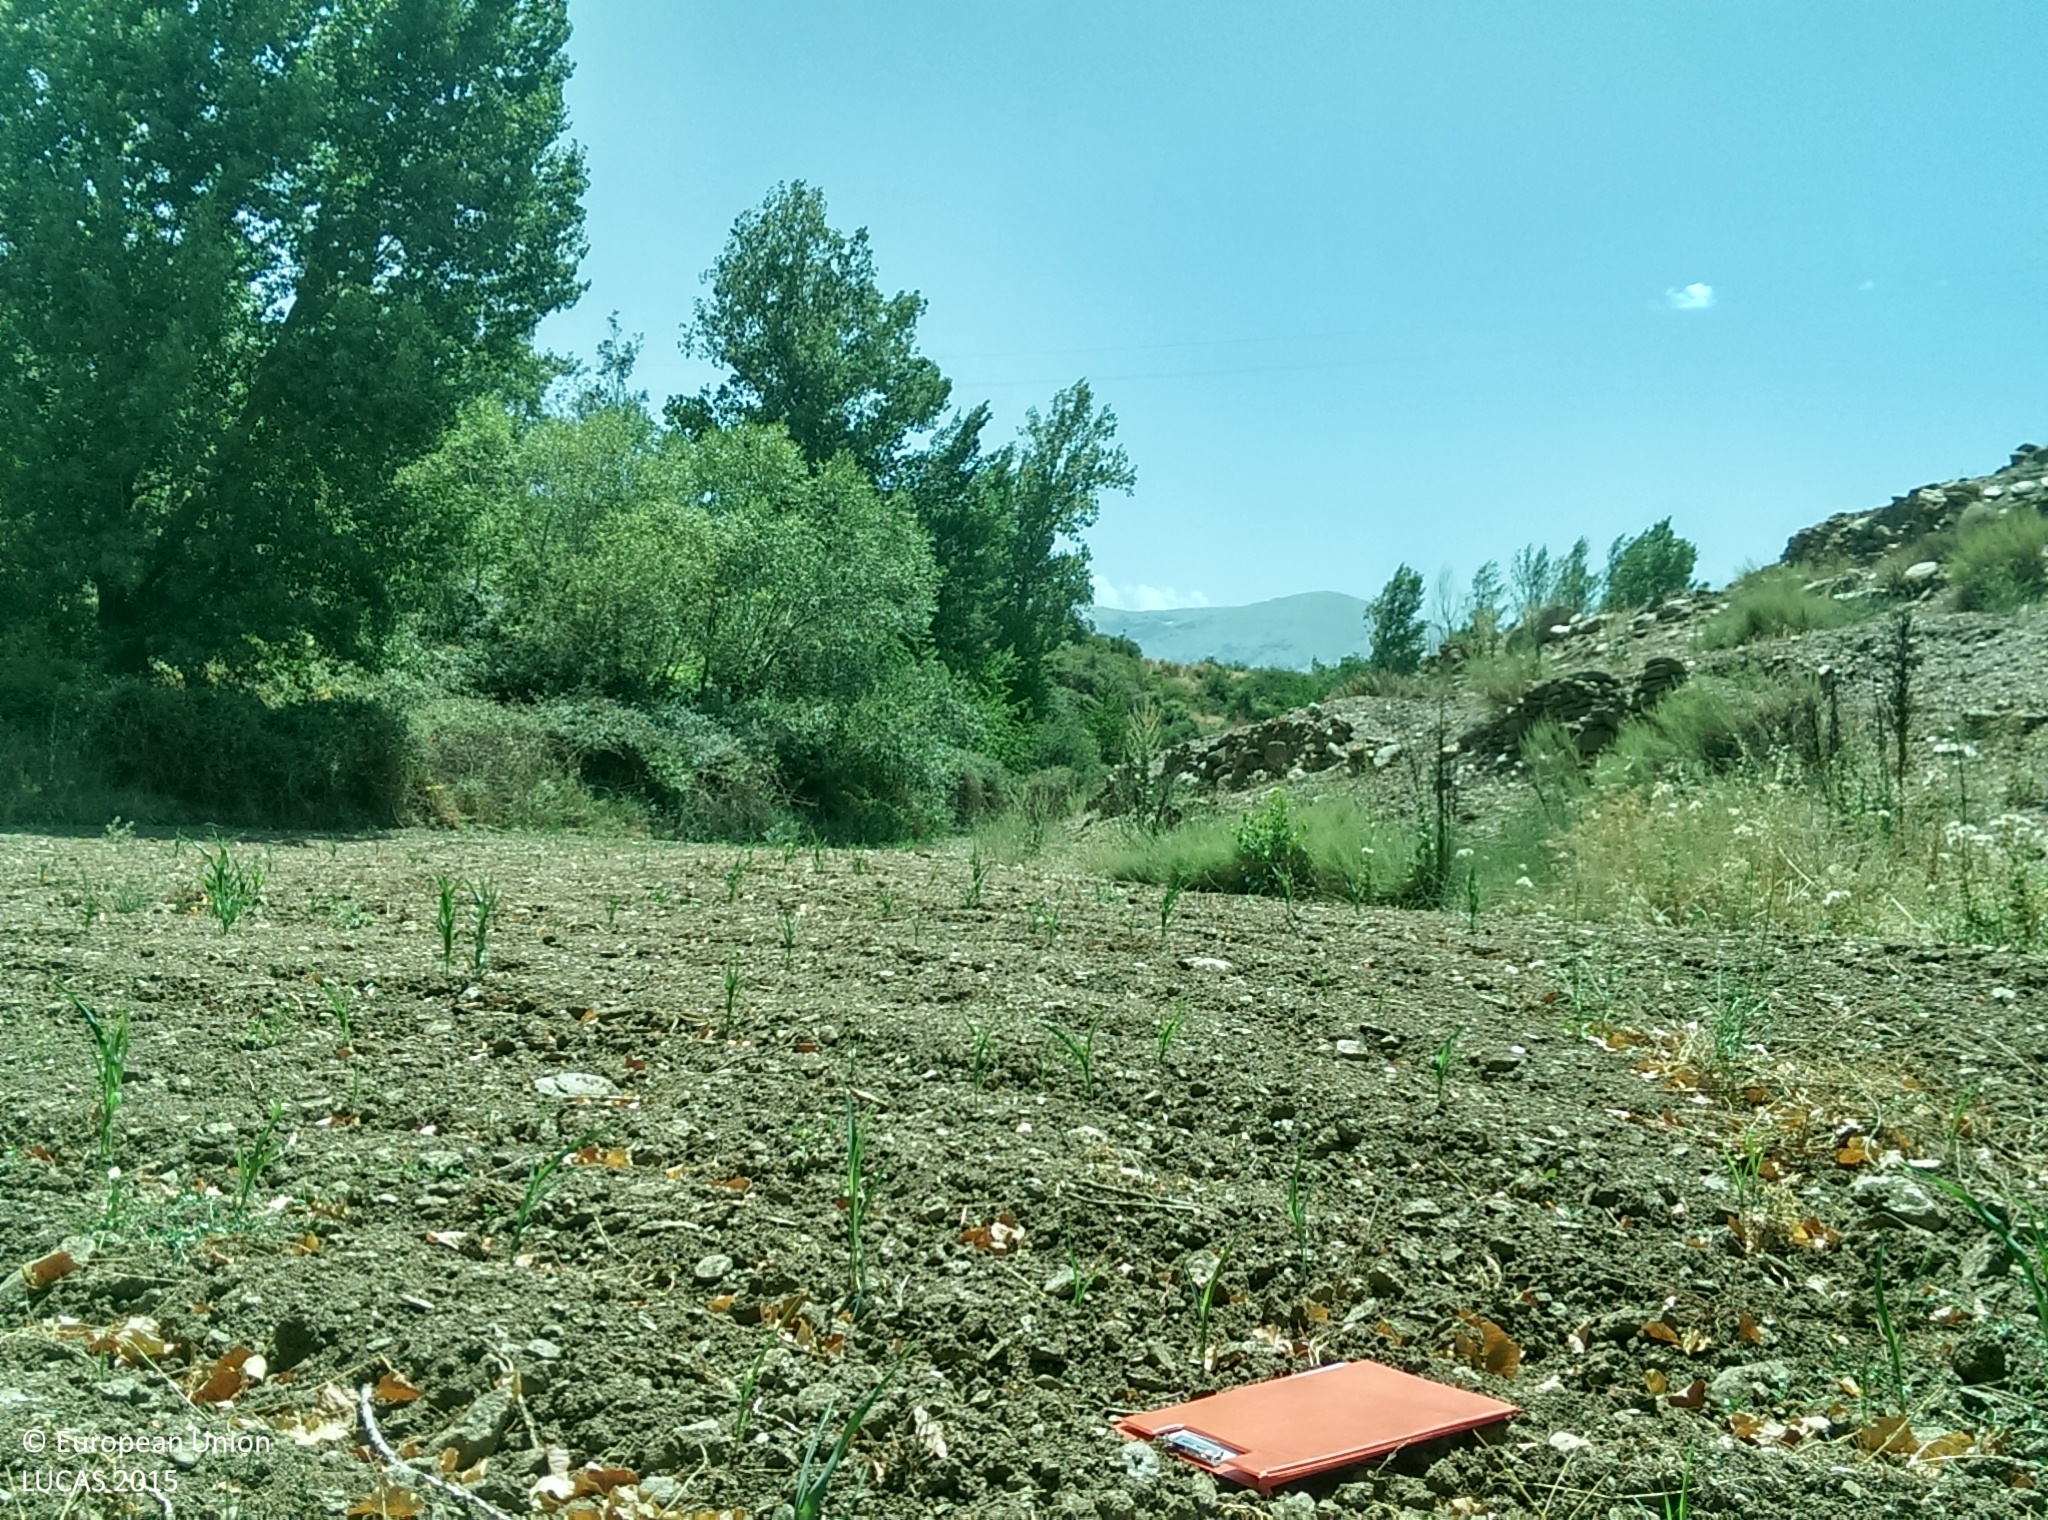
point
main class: Cropland
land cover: Maize
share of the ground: < 10 %
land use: Agriculture (excluding fallow land and kitchen gardens)
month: July
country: ES
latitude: 37.1963
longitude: -3.1556
